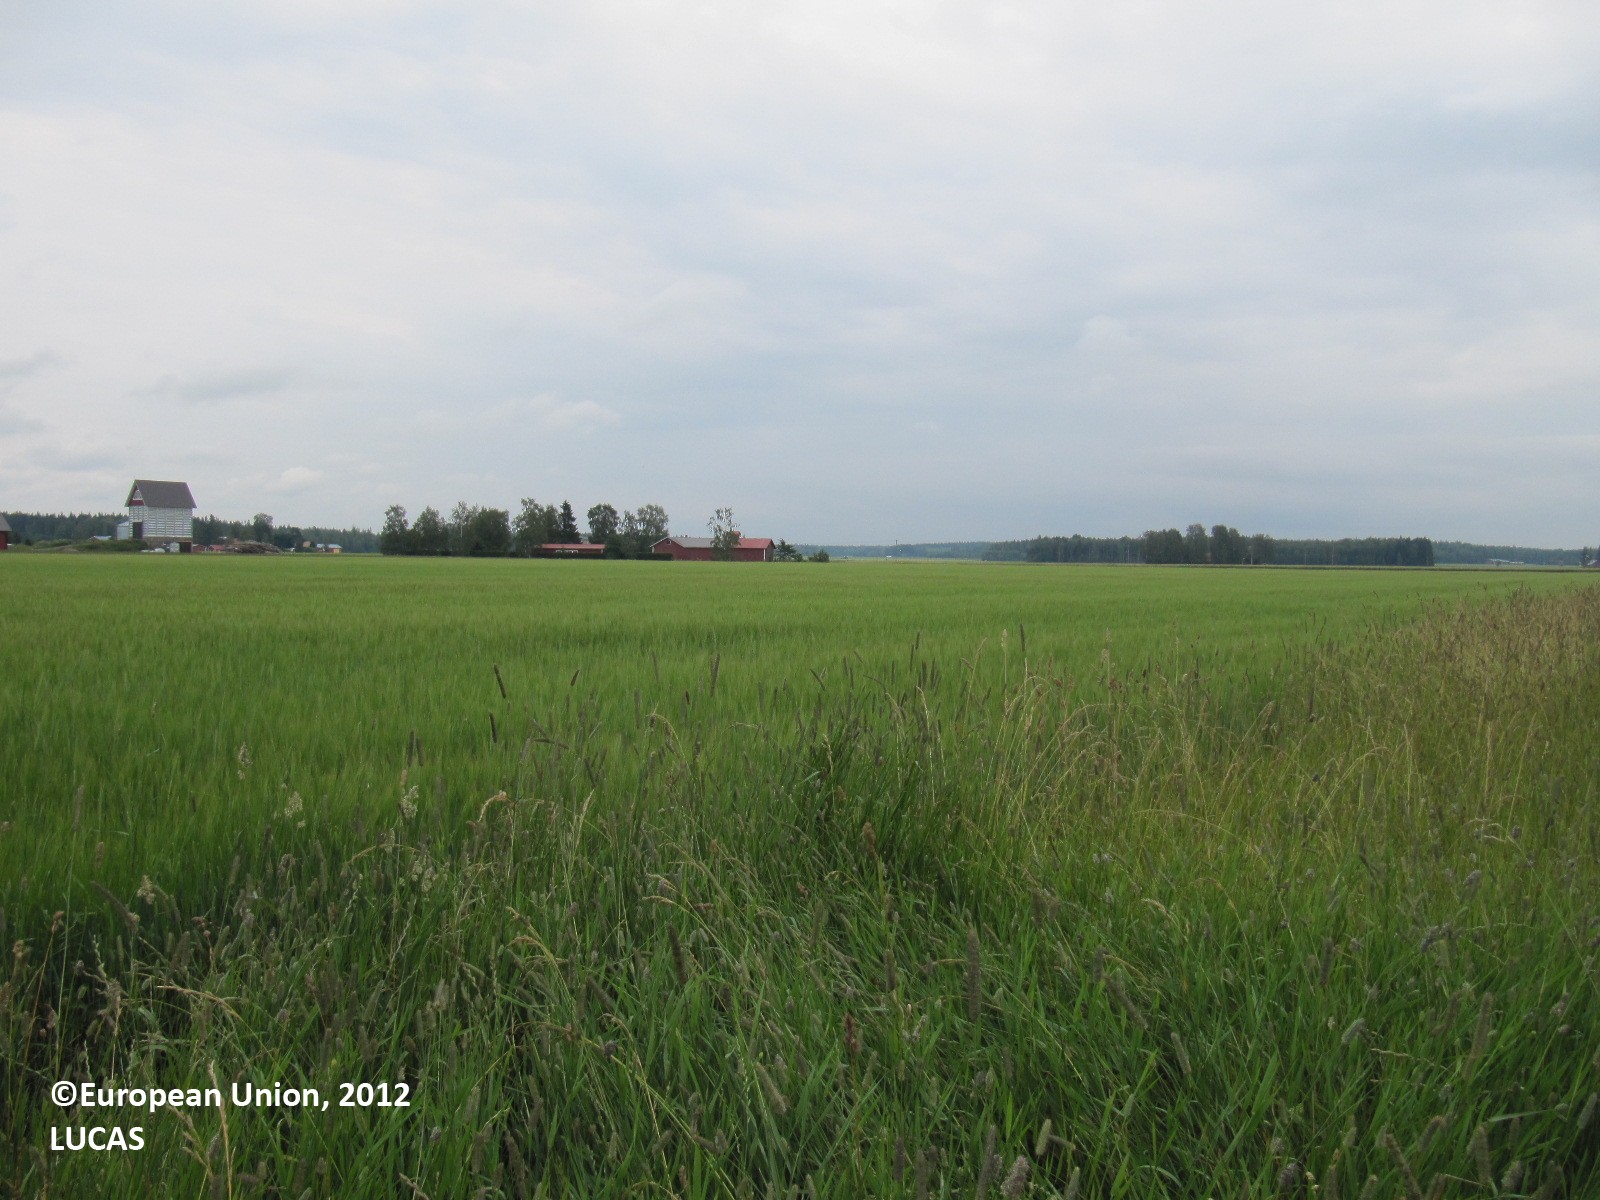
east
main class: Cropland
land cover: Temporary grasslands
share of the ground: > 75 %
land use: Agriculture (excluding fallow land and kitchen gardens)
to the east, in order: Temporary grasslands; Ditches and canals; Rye; Electric lines; Rye
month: July
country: FI
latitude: 60.7328
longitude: 23.3400
